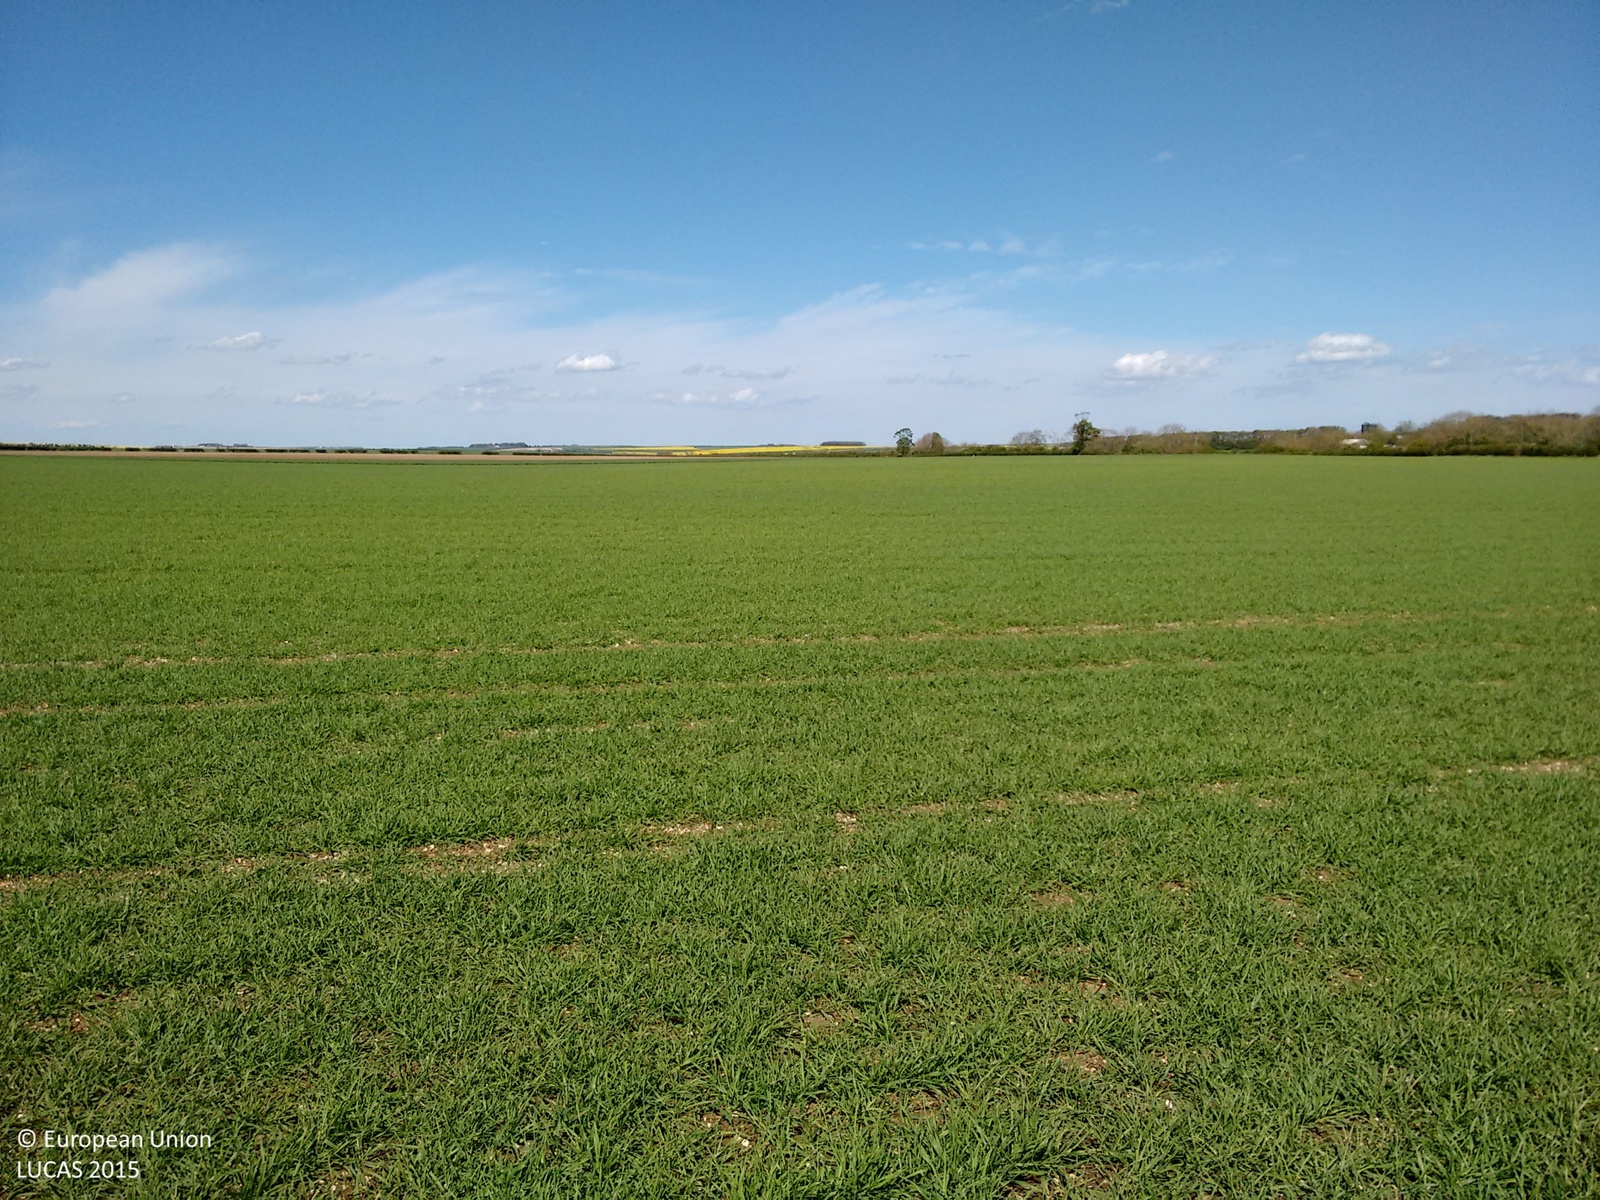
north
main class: Cropland
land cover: Barley
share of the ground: > 75 %
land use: Agriculture (excluding fallow land and kitchen gardens)
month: May
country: GB
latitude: 54.1015
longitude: -0.3265
